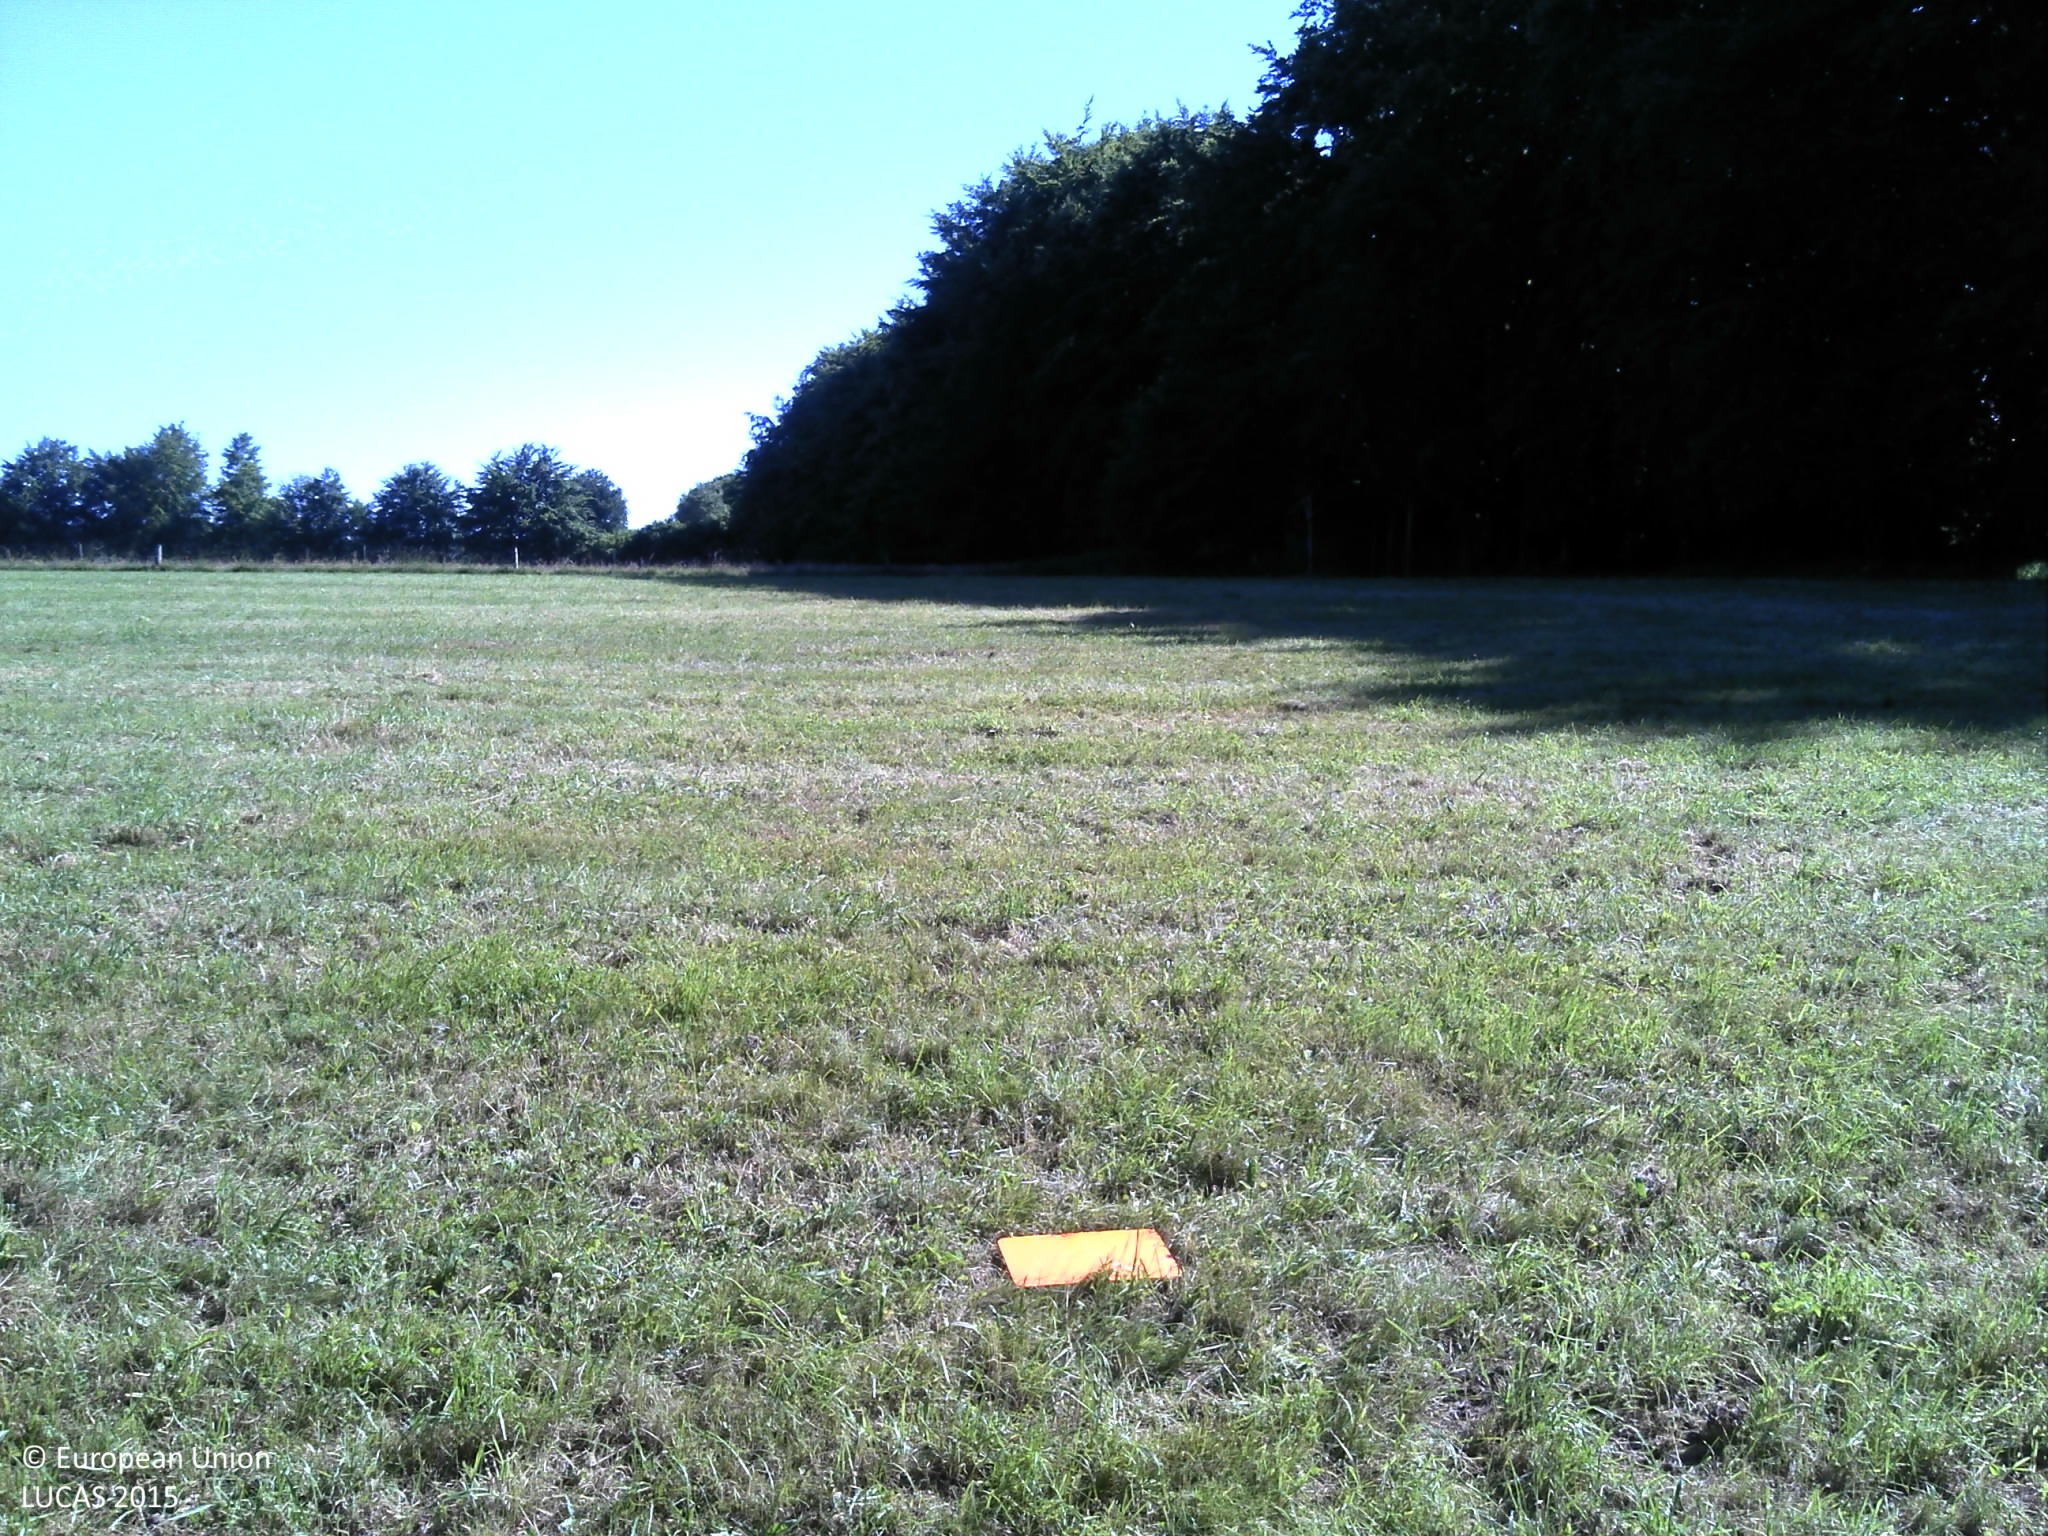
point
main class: Grassland
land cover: Grassland without tree/shrub cover
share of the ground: > 75 %
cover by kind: herbaceous plants 100 %
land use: Agriculture (excluding fallow land and kitchen gardens)
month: June
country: FR
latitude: 49.9574
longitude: 4.7977
